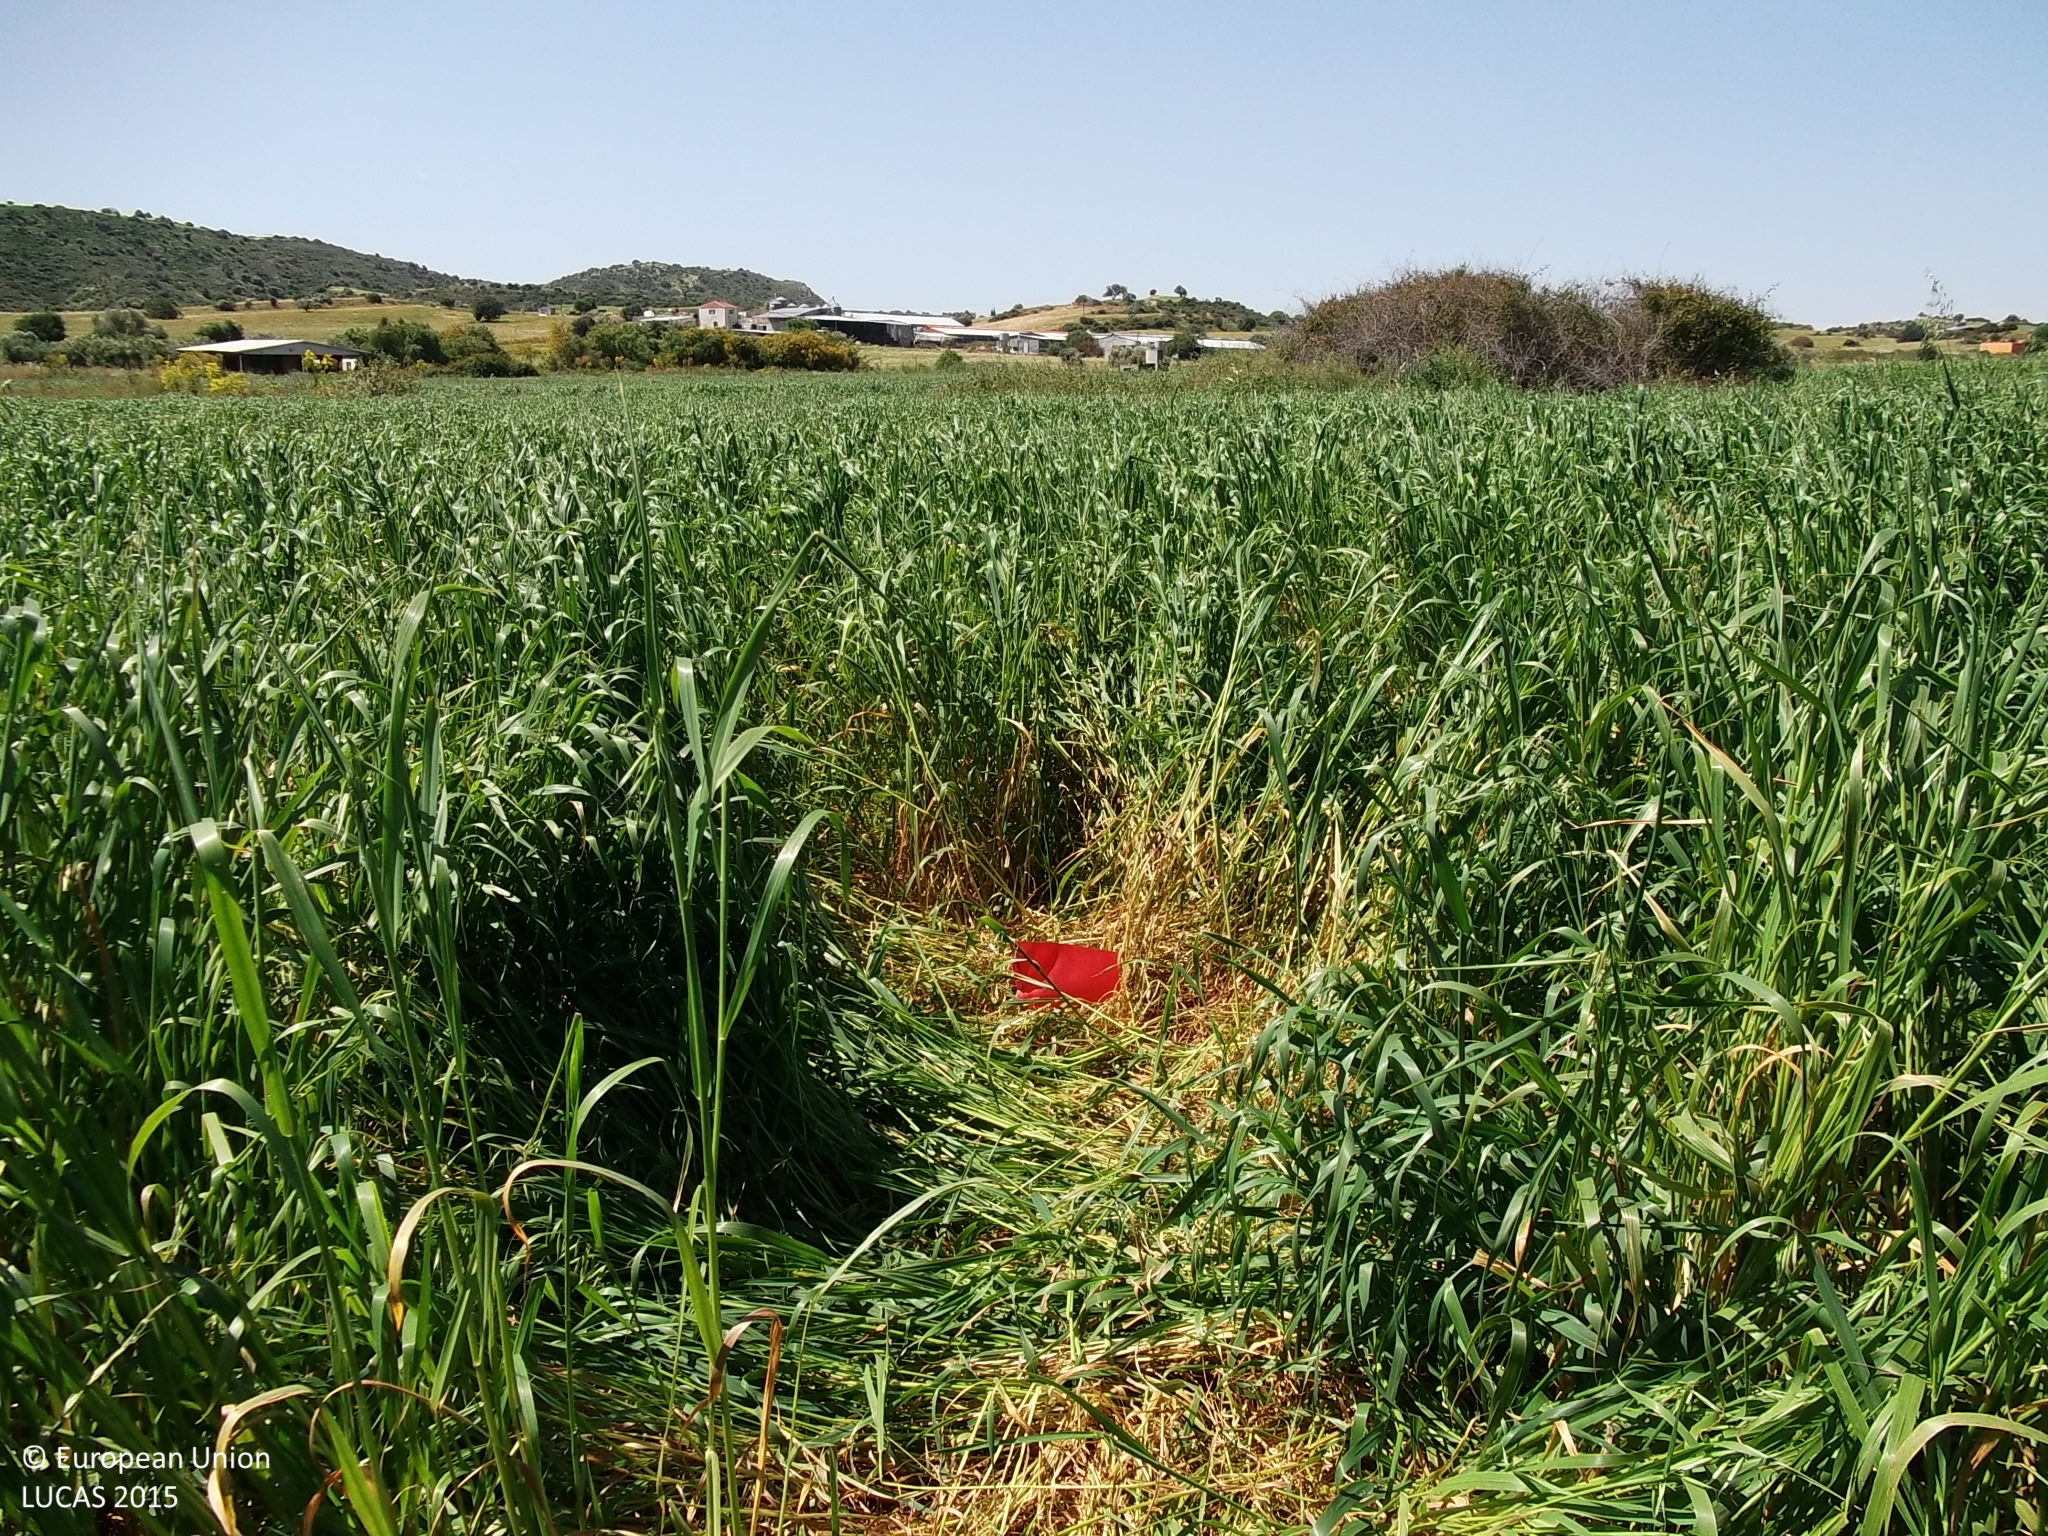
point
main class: Cropland
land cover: Oats
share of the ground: > 75 %
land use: Agriculture (excluding fallow land and kitchen gardens)
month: April
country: CY
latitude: 34.8179
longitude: 33.4160
